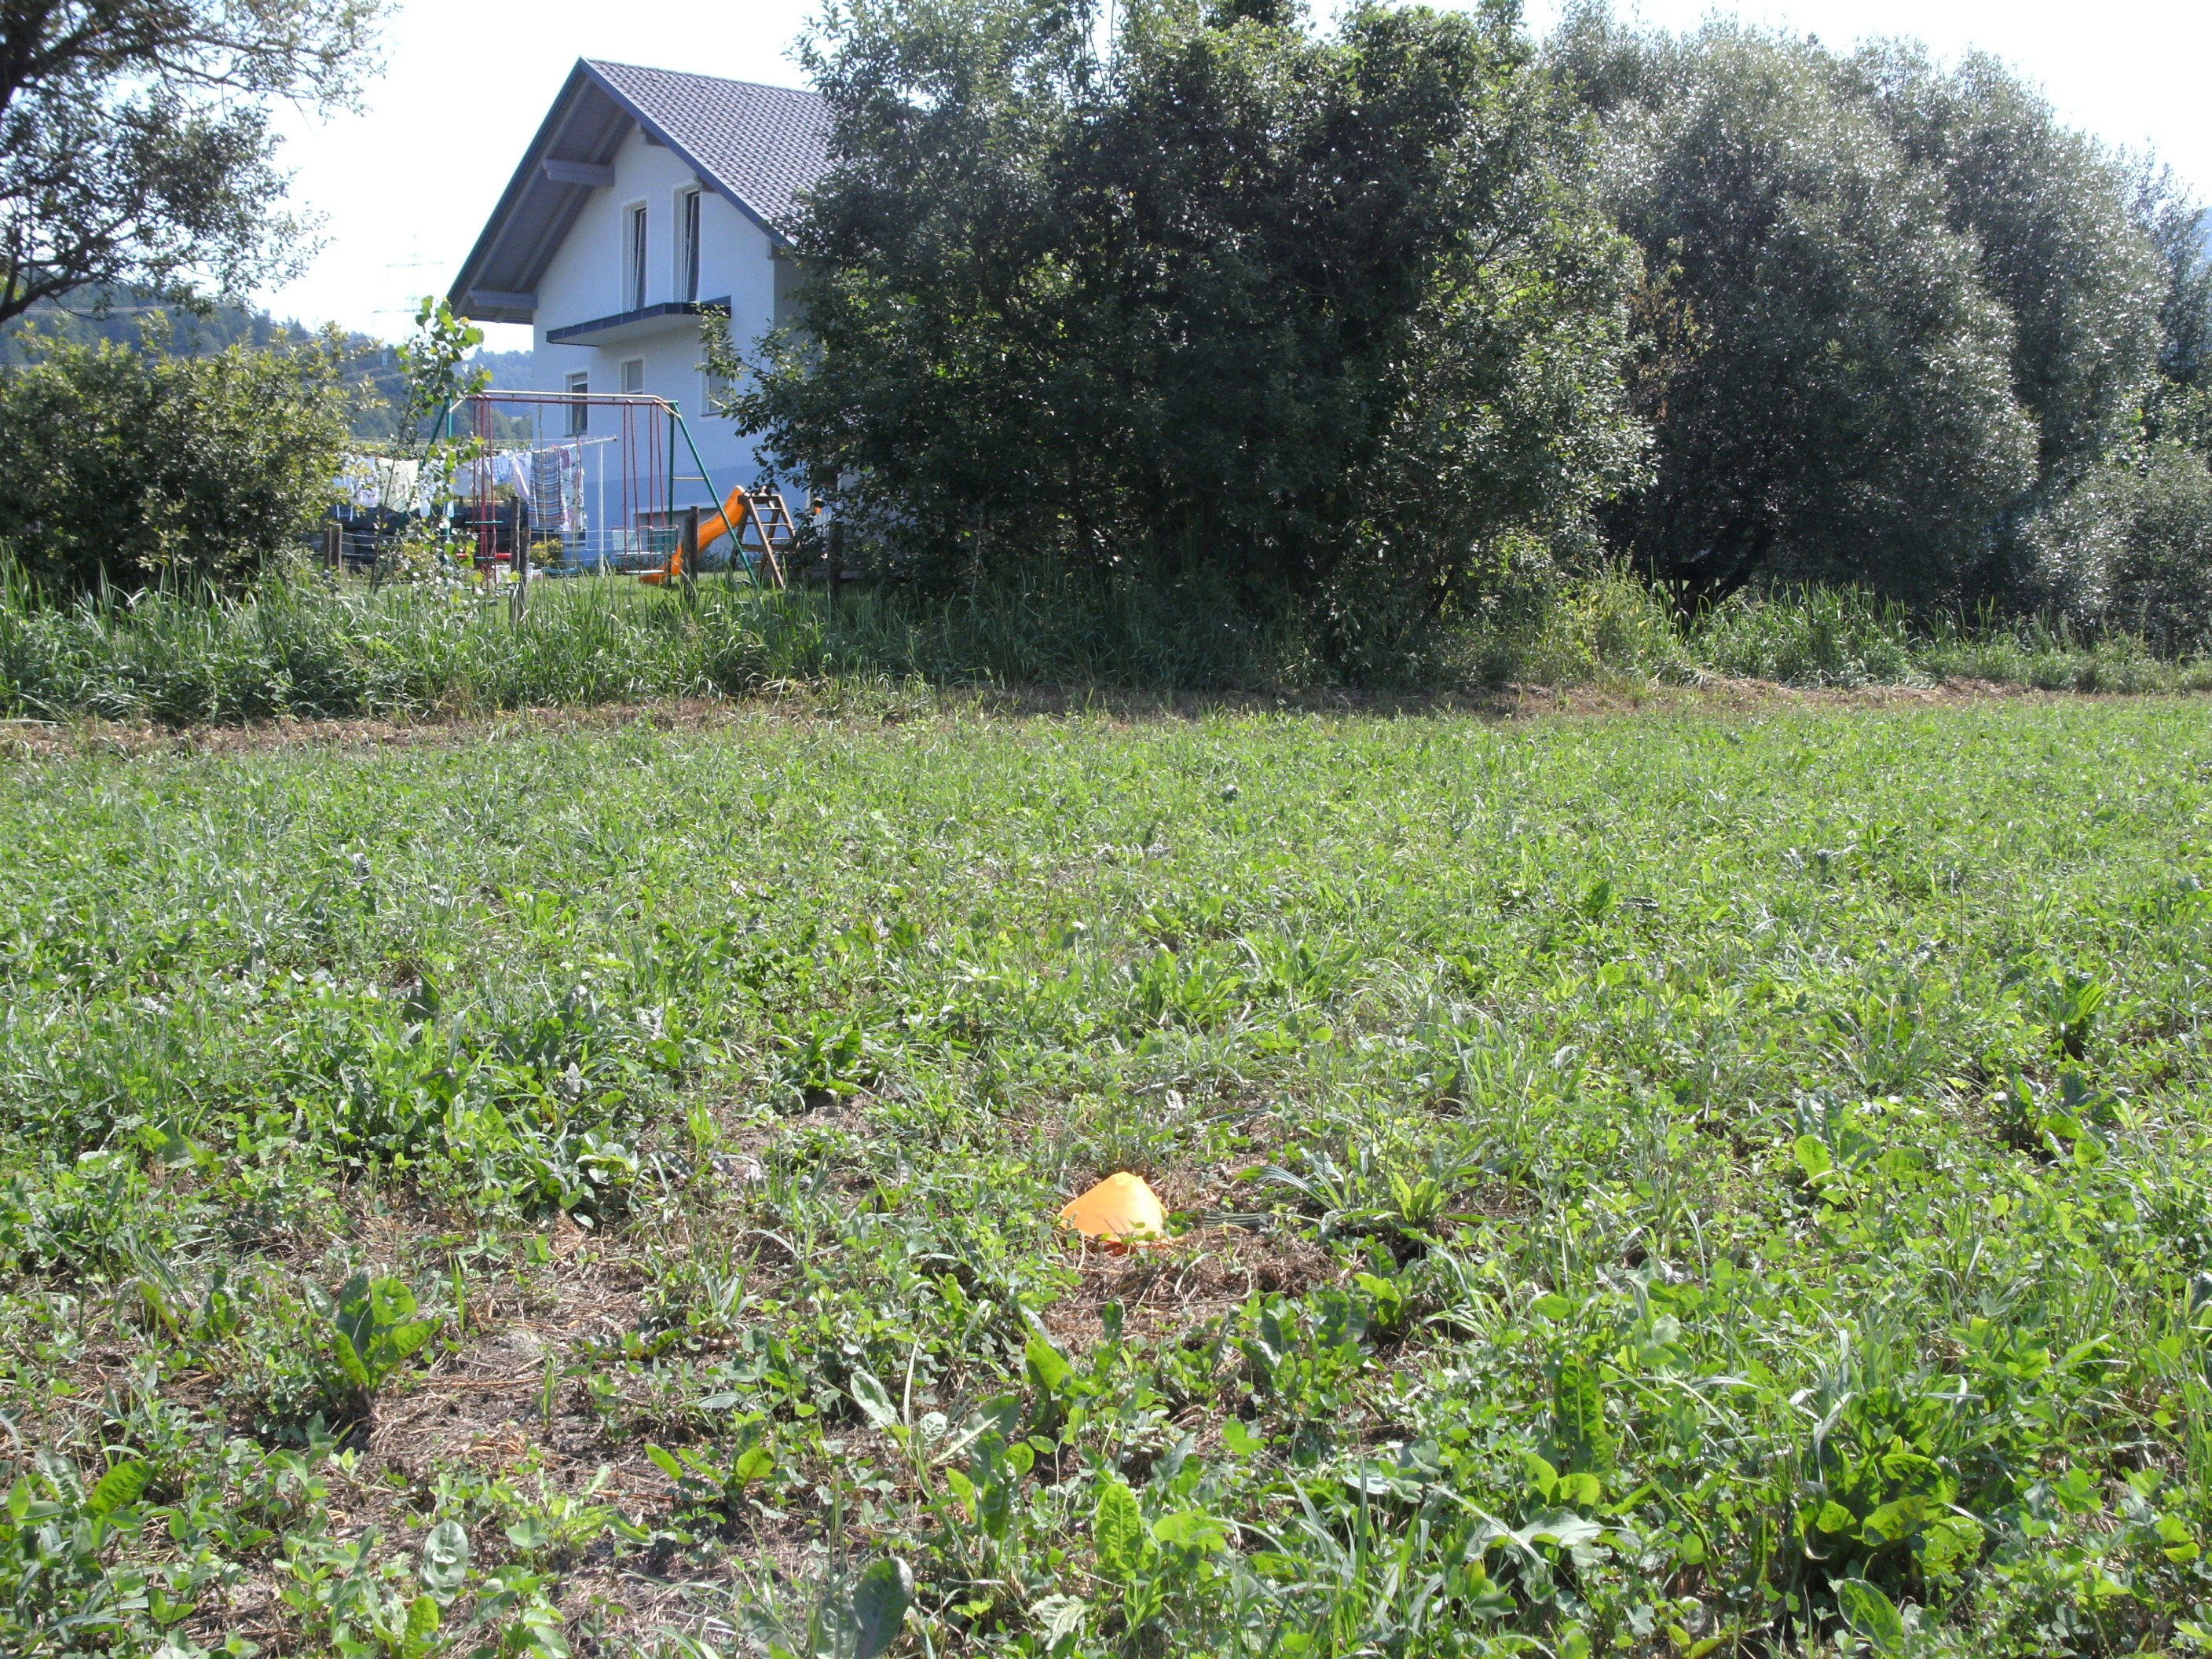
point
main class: Cropland
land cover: Temporary grasslands
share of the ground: > 75 %
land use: Agriculture (excluding fallow land and kitchen gardens)
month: July
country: AT
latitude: 46.6778
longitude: 14.7696
